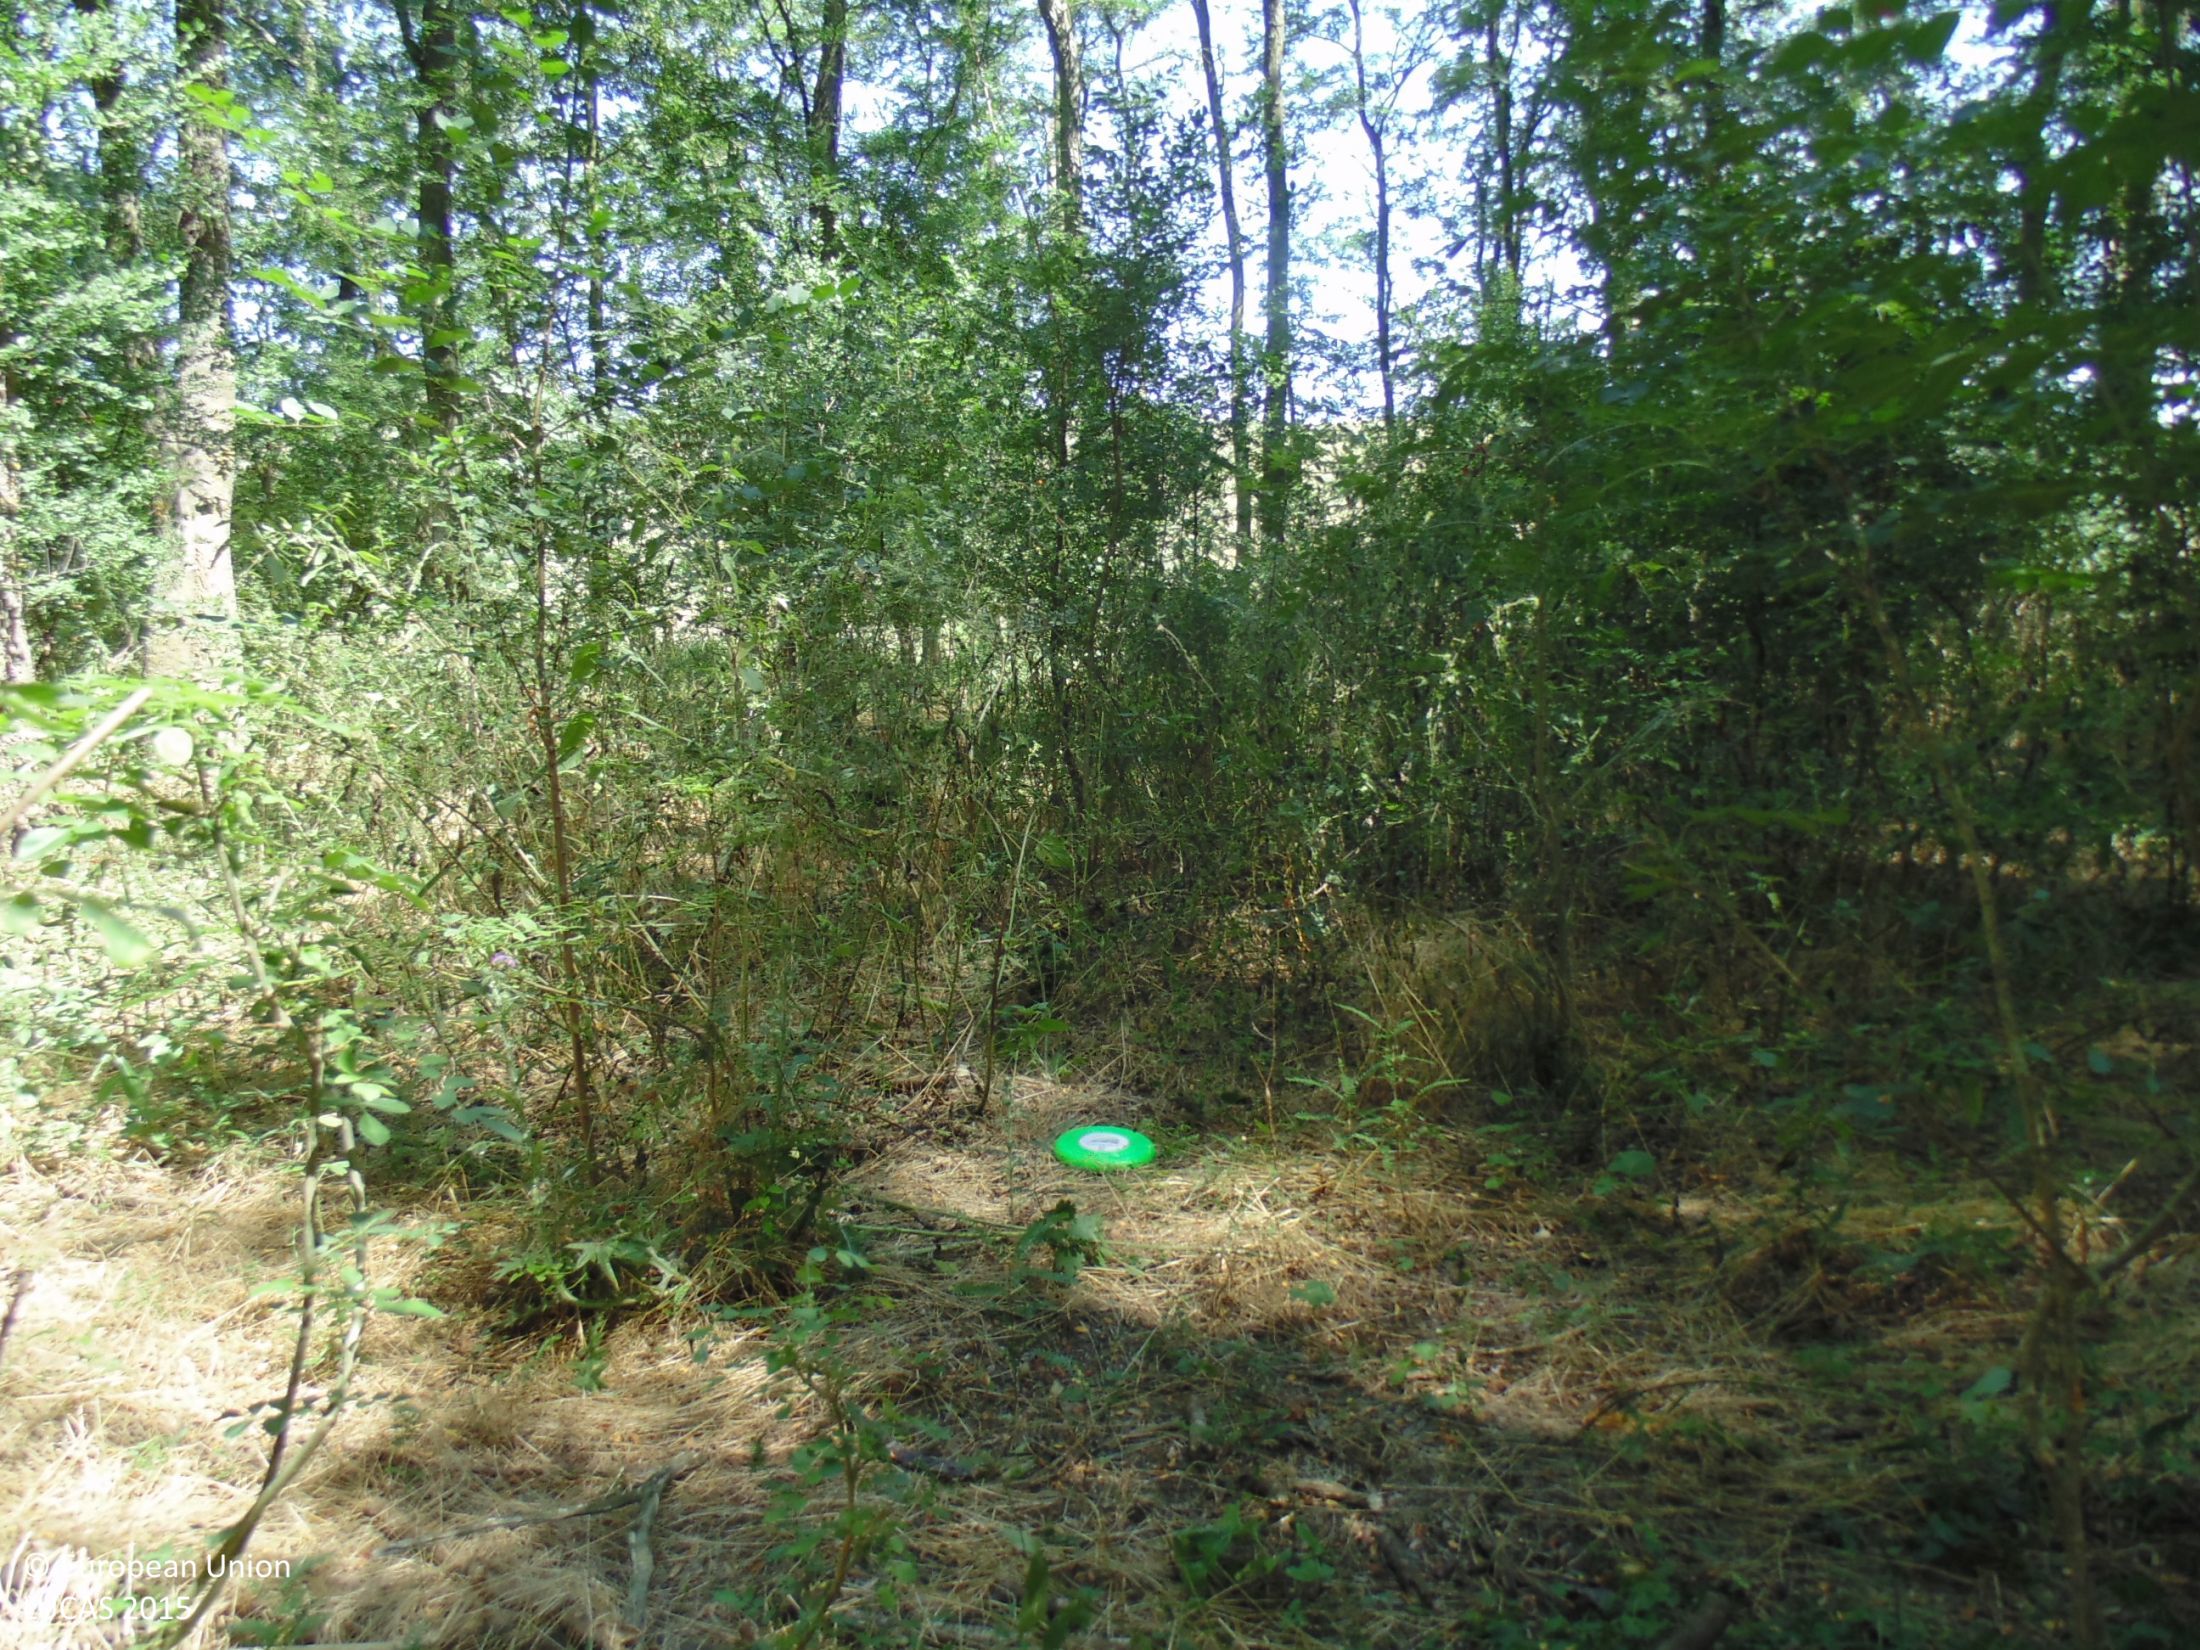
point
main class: Woodland
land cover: Broadleaved woodland
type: mesophytic deciduous forest
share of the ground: > 75 %
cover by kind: broadleaved forest trees 85 %, herbaceous plants 10 %, shrubs 5 %
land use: Forestry
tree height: > 5 m
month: August
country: BG
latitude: 43.6266
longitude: 28.2108
